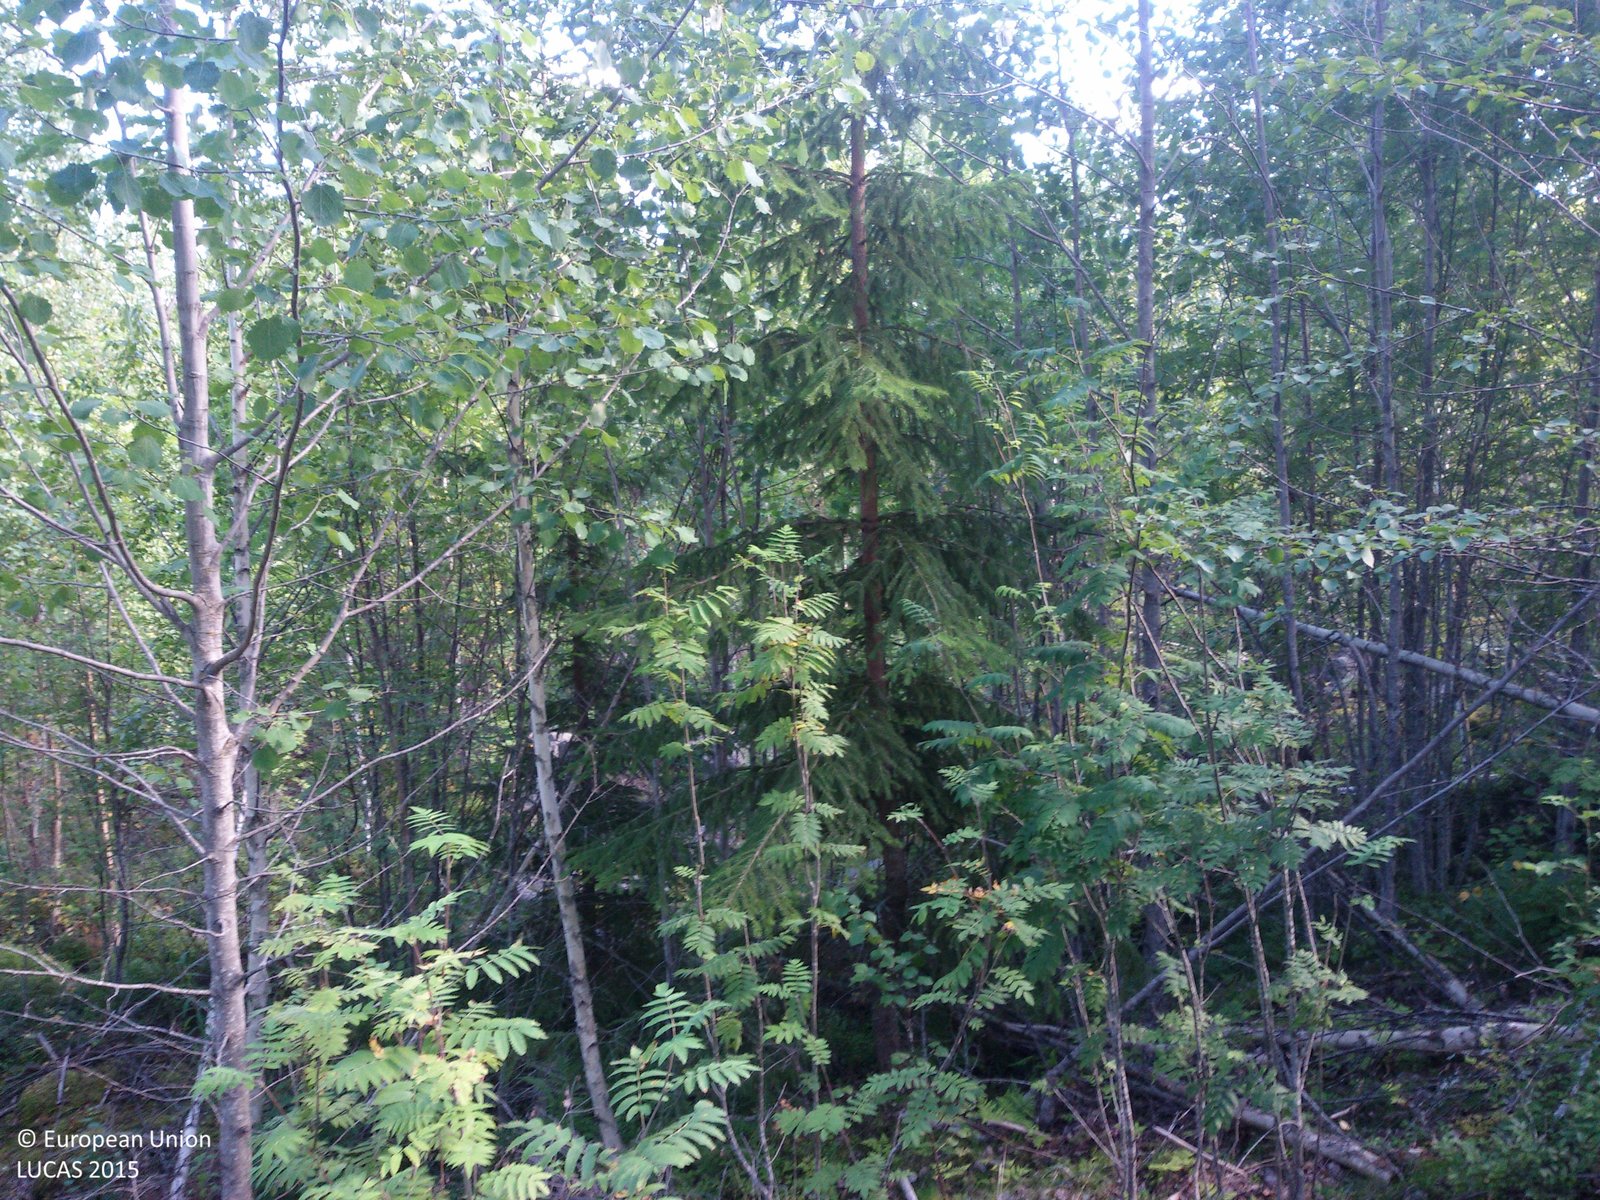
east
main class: Woodland
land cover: Broadleaved woodland
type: boreal forest
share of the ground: 50 - 75 %
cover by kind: broadleaved forest trees 65 %, herbaceous plants 15 %, lichens and mosses 15 %, coniferous forest trees 5 %
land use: Forestry
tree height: > 5 m
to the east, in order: Broadleaved woodland; Ditches and canals; Paved roads, cycling and walking lanes; Grass margins; Spontaneously vegetated surfaces; Inland fresh water bodies
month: August
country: SE
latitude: 60.7610
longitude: 15.9149
